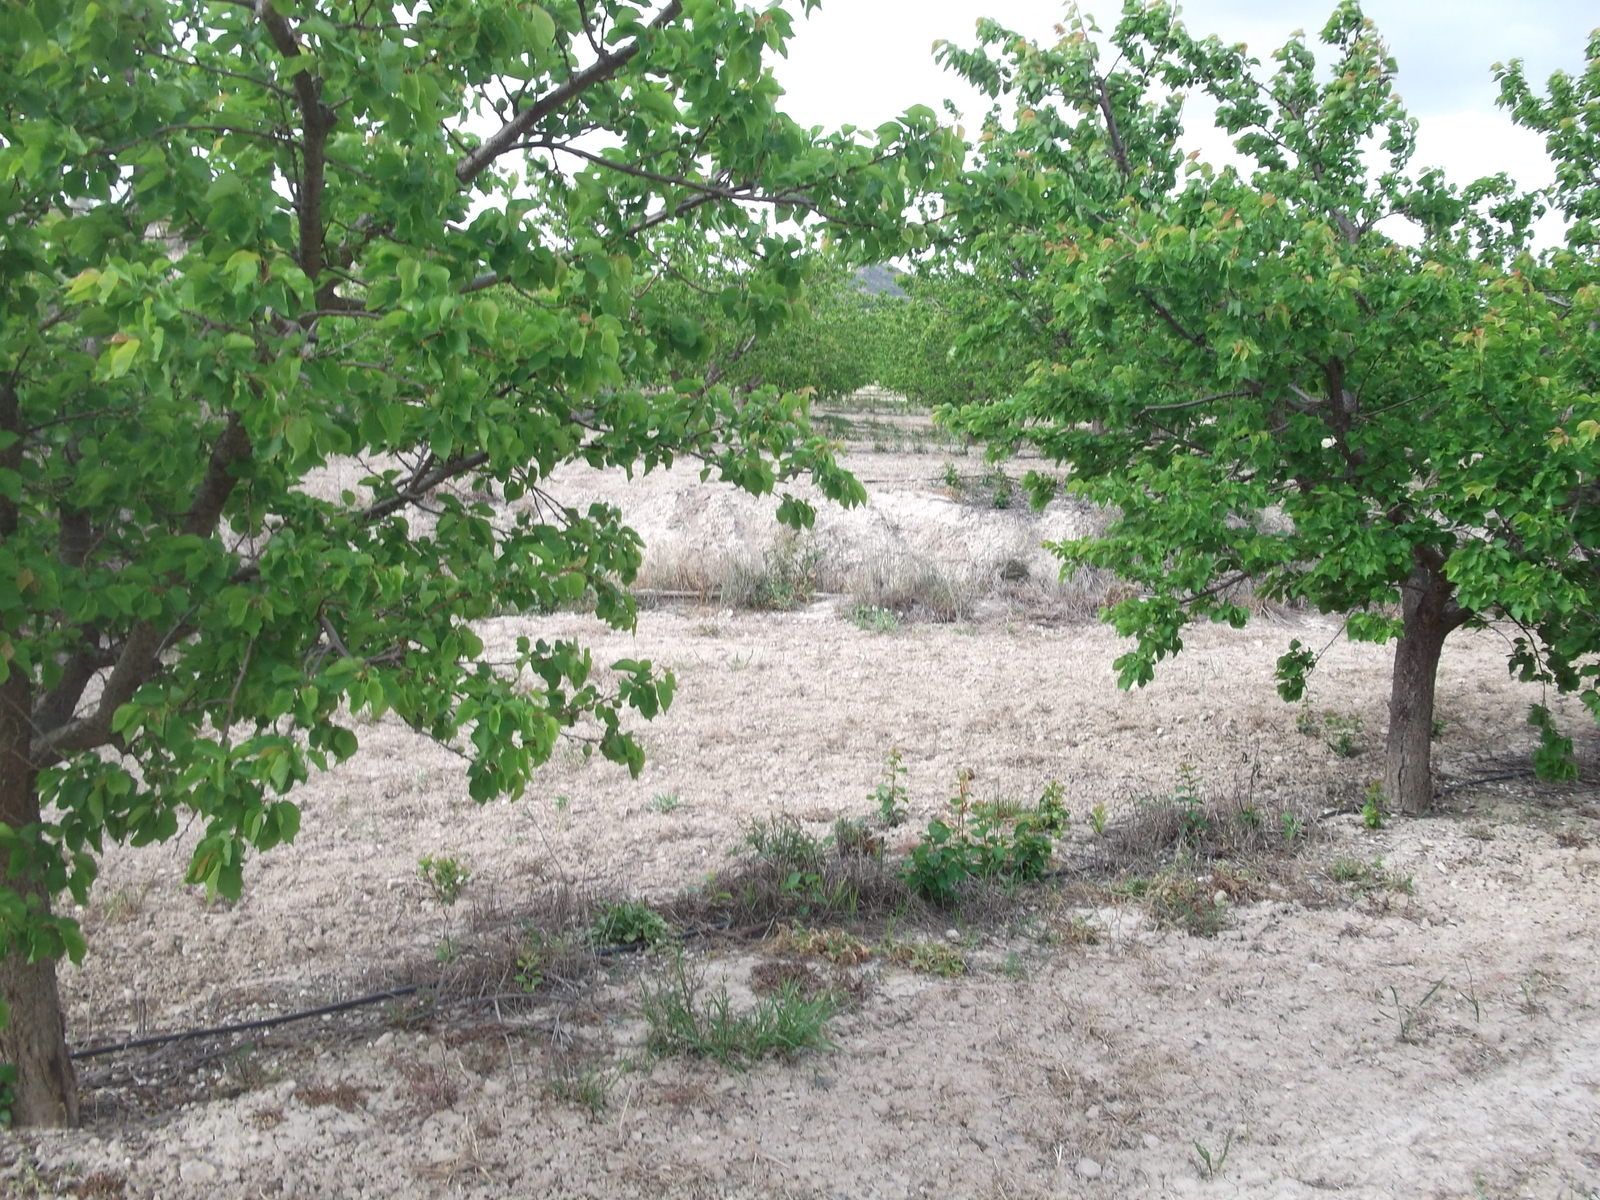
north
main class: Cropland
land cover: Other fruit trees and berries
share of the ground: 10 - 25 %
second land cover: Other bare soil
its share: > 75 %
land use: Agriculture (excluding fallow land and kitchen gardens)
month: April
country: ES
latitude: 38.0321
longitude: -1.5274
